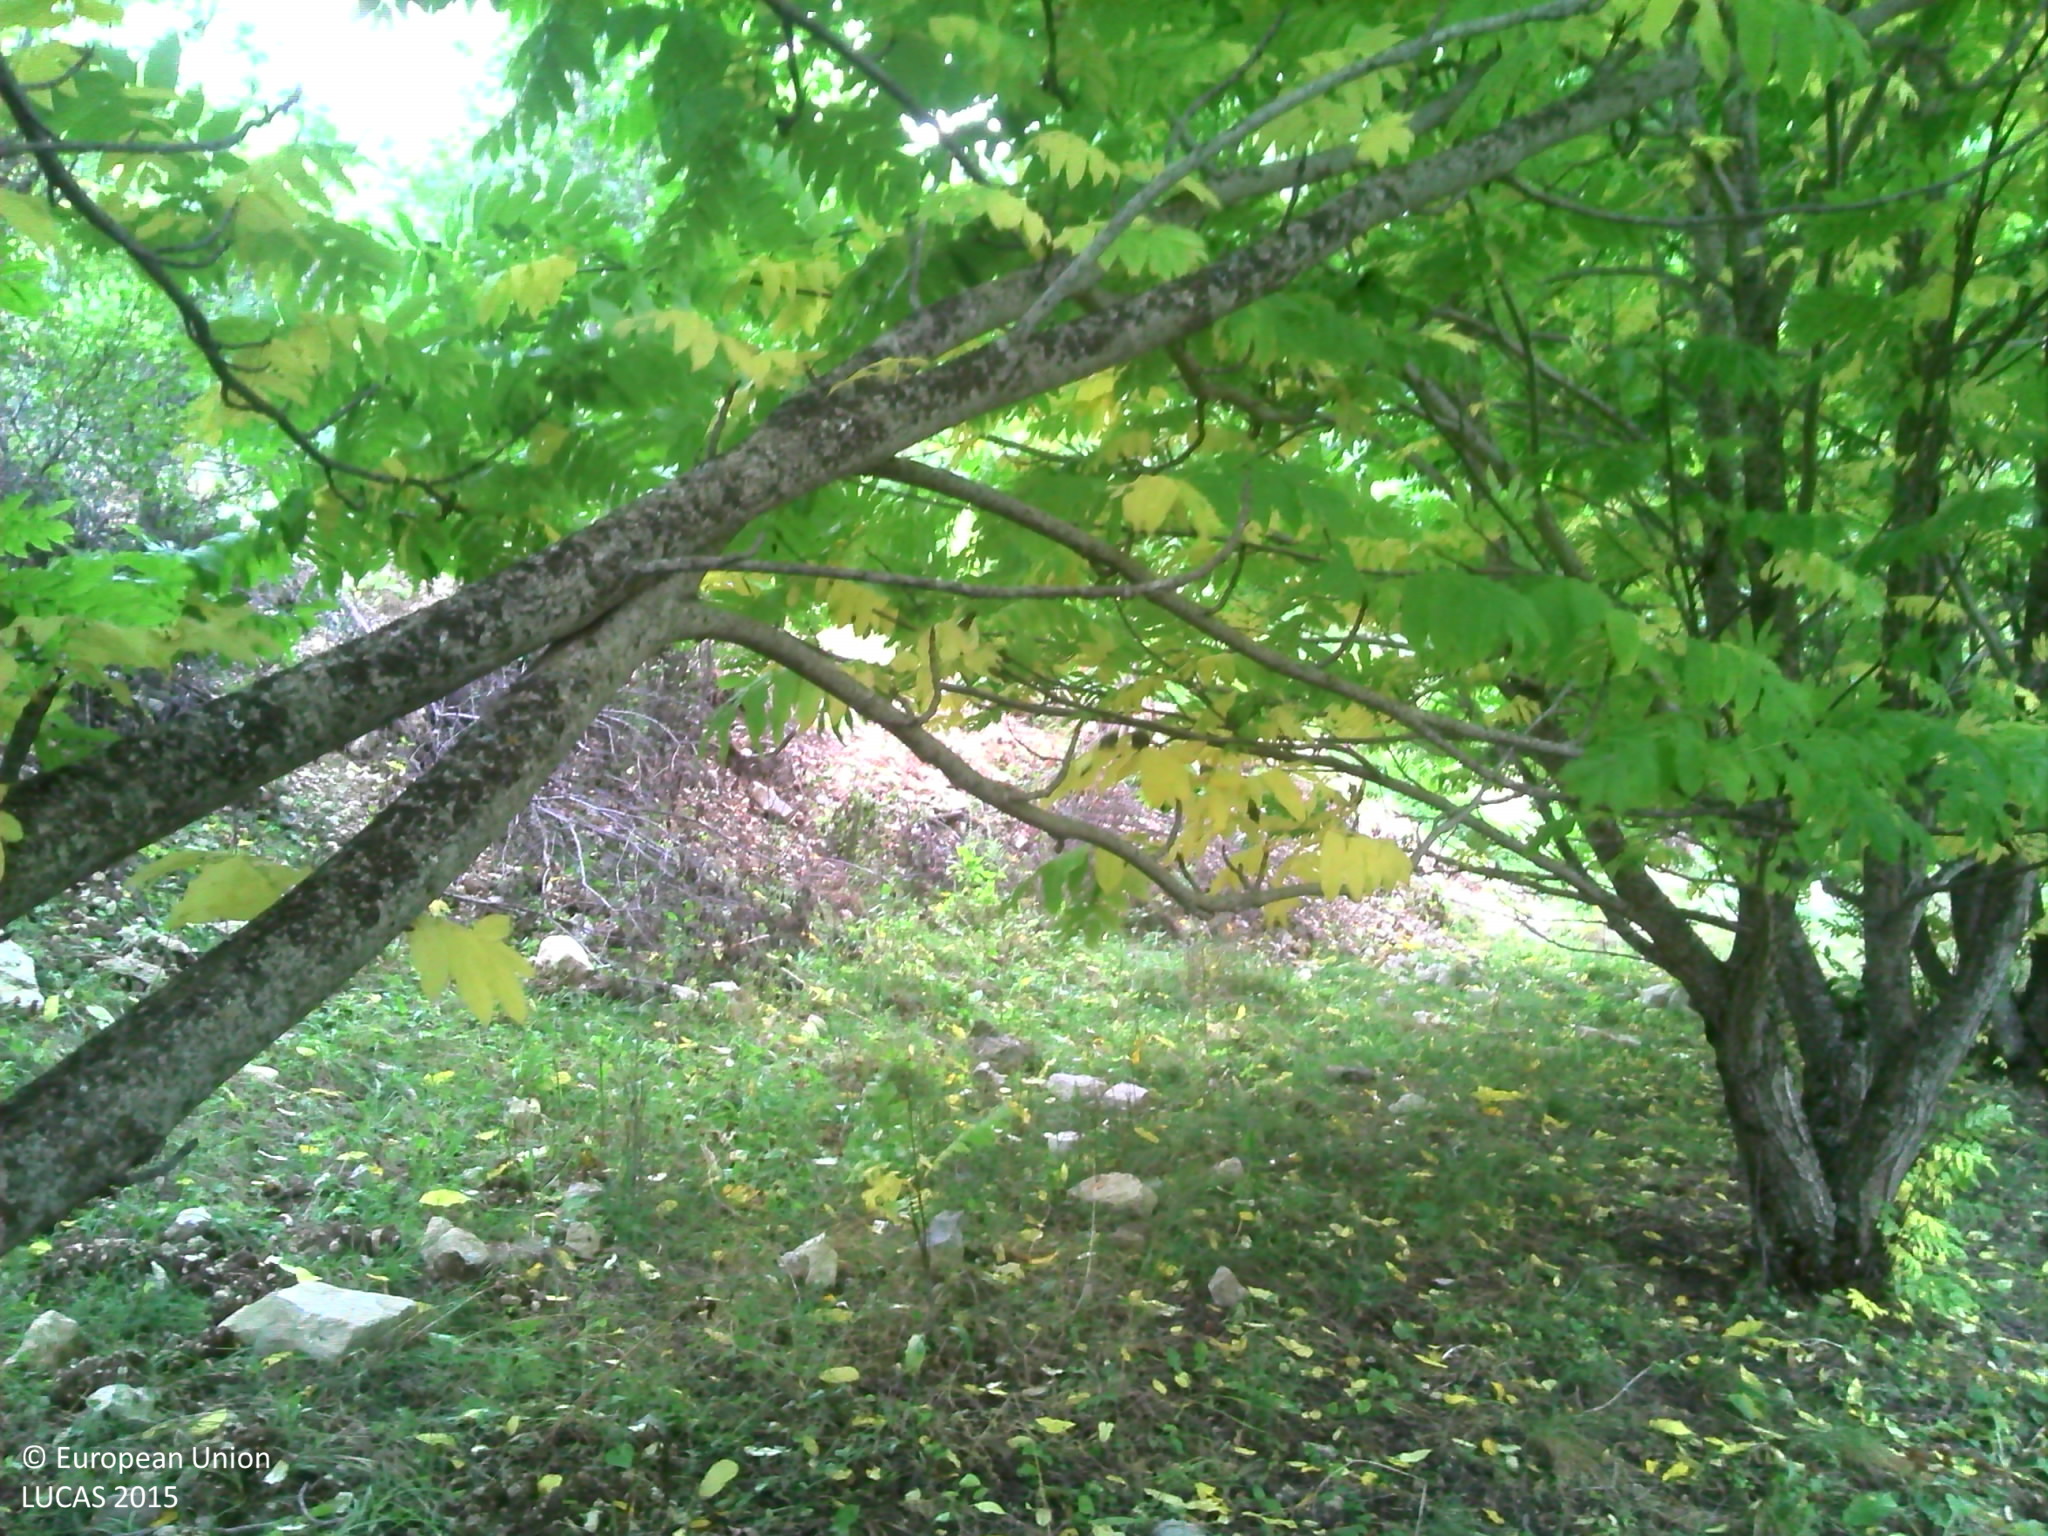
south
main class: Cropland
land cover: Nuts trees
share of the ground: 50 - 75 %
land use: Agriculture (excluding fallow land and kitchen gardens)
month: September
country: FR
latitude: 44.4346
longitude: 5.5222
